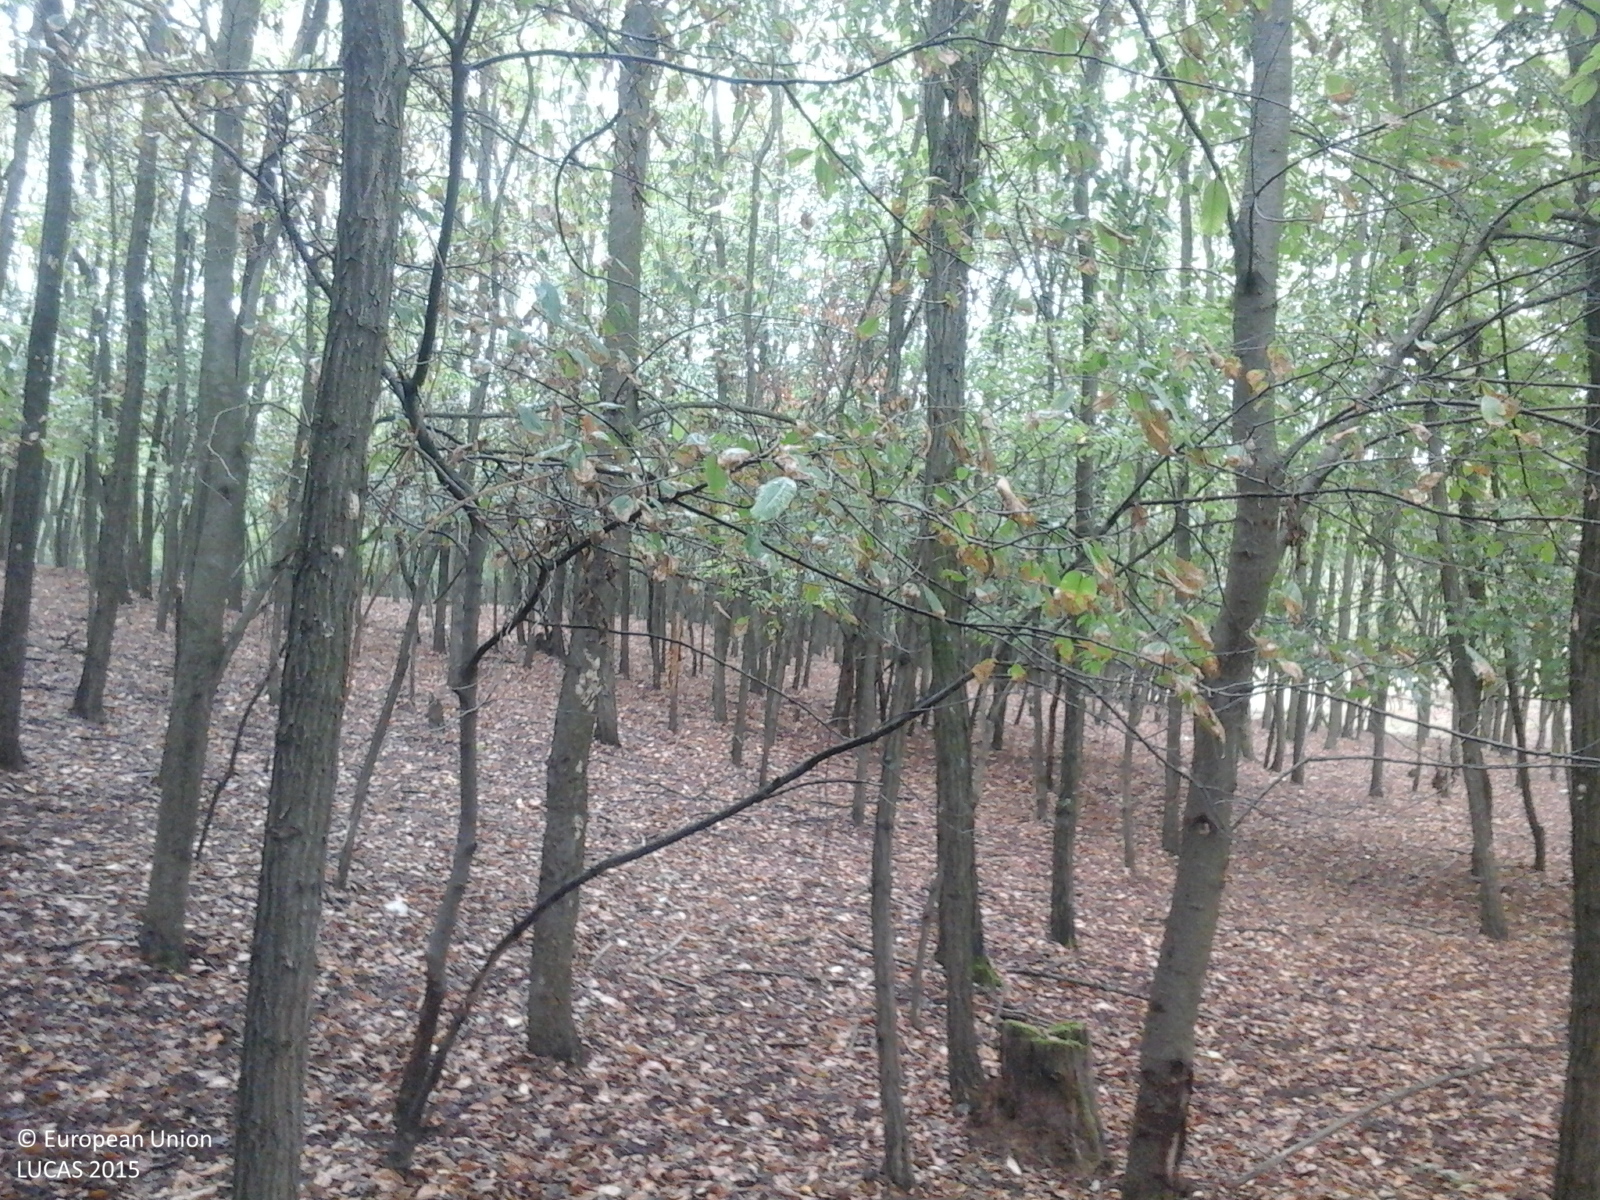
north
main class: Woodland
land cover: Broadleaved woodland
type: mesophytic deciduous forest
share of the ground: > 75 %
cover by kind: broadleaved forest trees 100 %
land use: Forestry
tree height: > 5 m
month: September
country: RO
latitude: 47.6630
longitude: 22.2654
